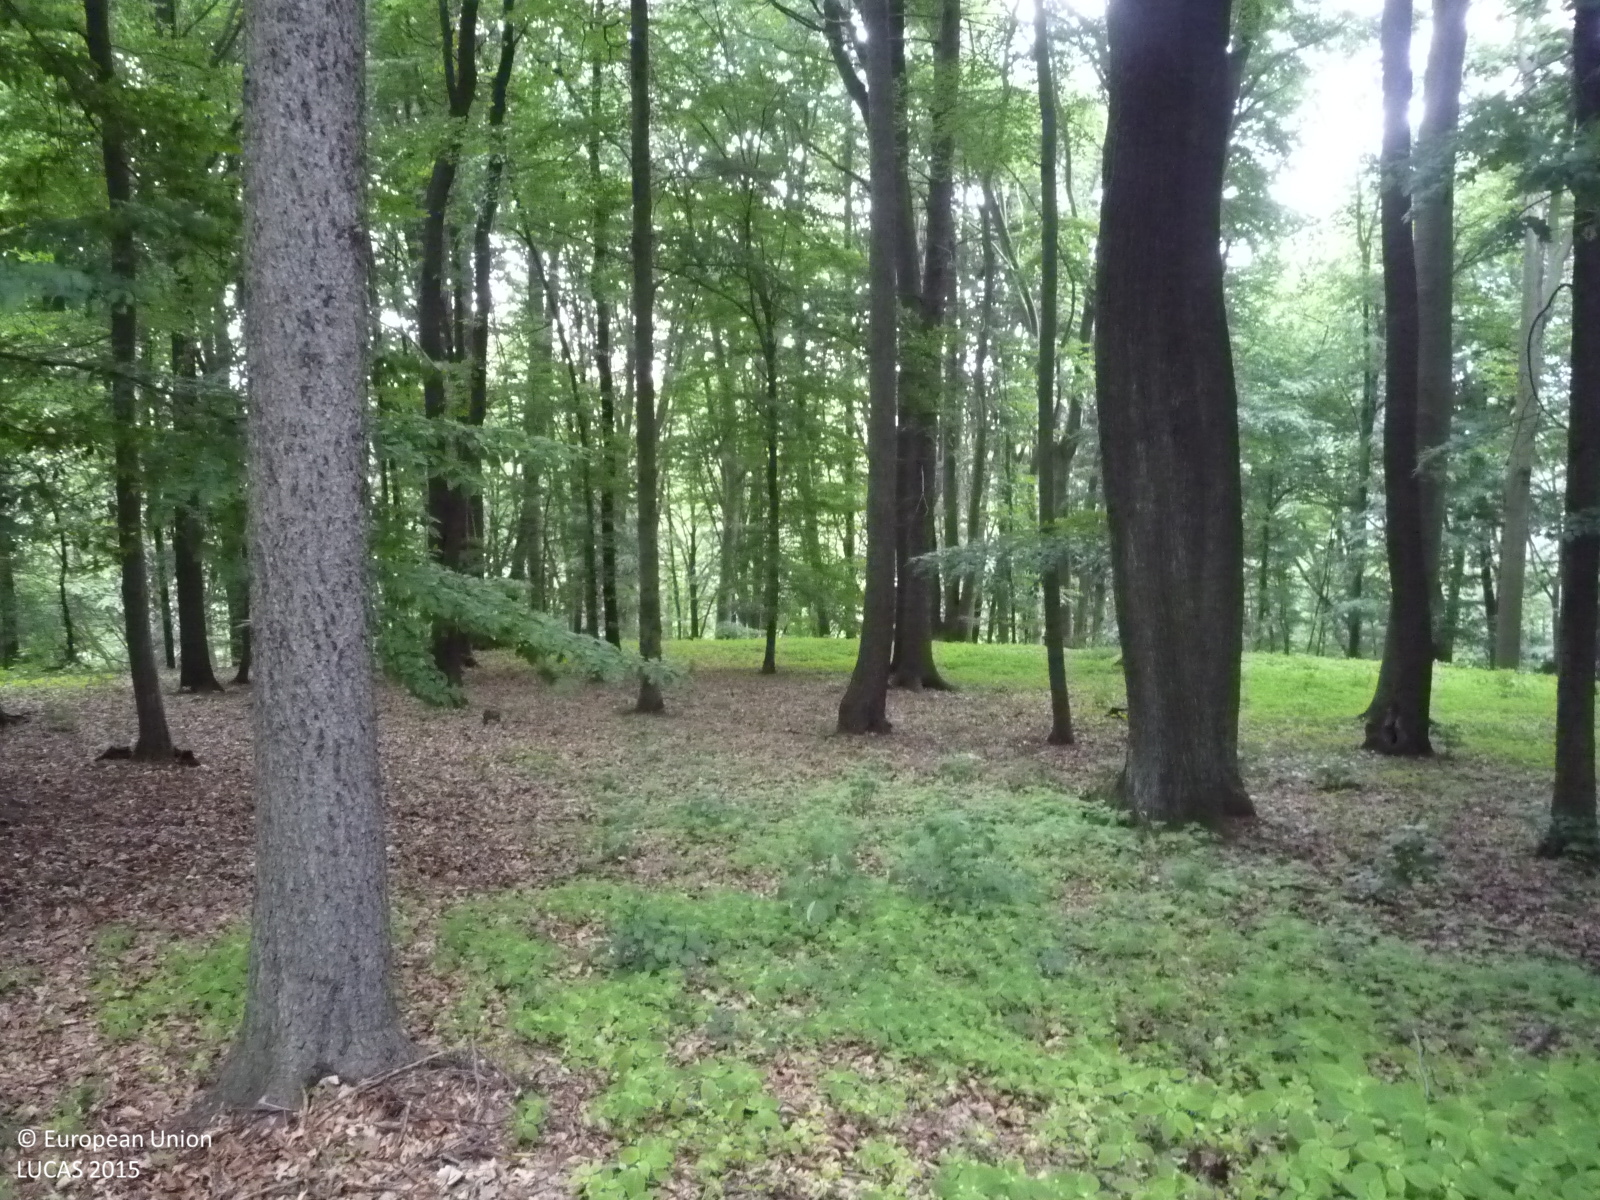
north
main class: Woodland
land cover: Broadleaved woodland
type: non-riverine alder, birch or aspen forest
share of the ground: > 75 %
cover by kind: broadleaved forest trees 80 %, coniferous forest trees 10 %, herbaceous plants 10 %
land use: Forestry
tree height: > 5 m
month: June
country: CZ
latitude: 49.9036
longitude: 15.1965
